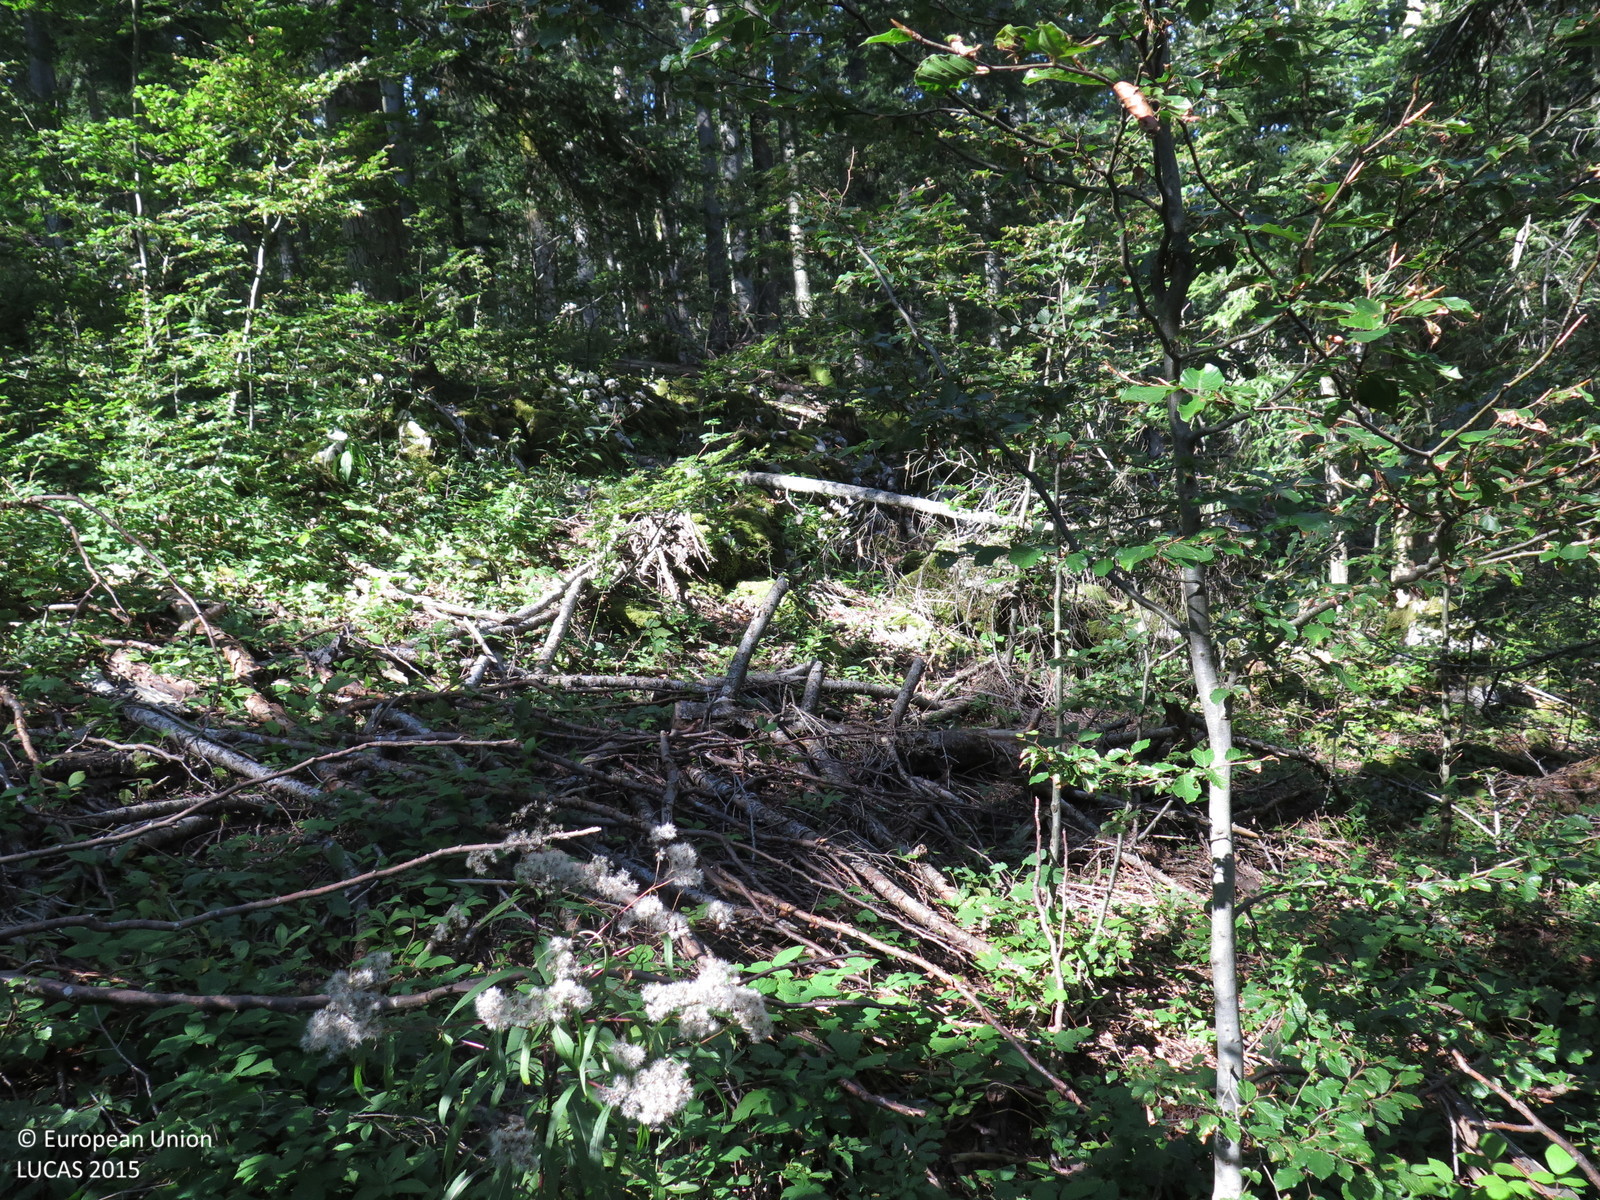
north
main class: Woodland
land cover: Other mixed woodland
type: alpine coniferous forest
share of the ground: > 75 %
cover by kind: coniferous forest trees 75 %, broadleaved forest trees 25 %
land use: Forestry
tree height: > 5 m
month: September
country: HR
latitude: 45.3982
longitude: 14.7346
